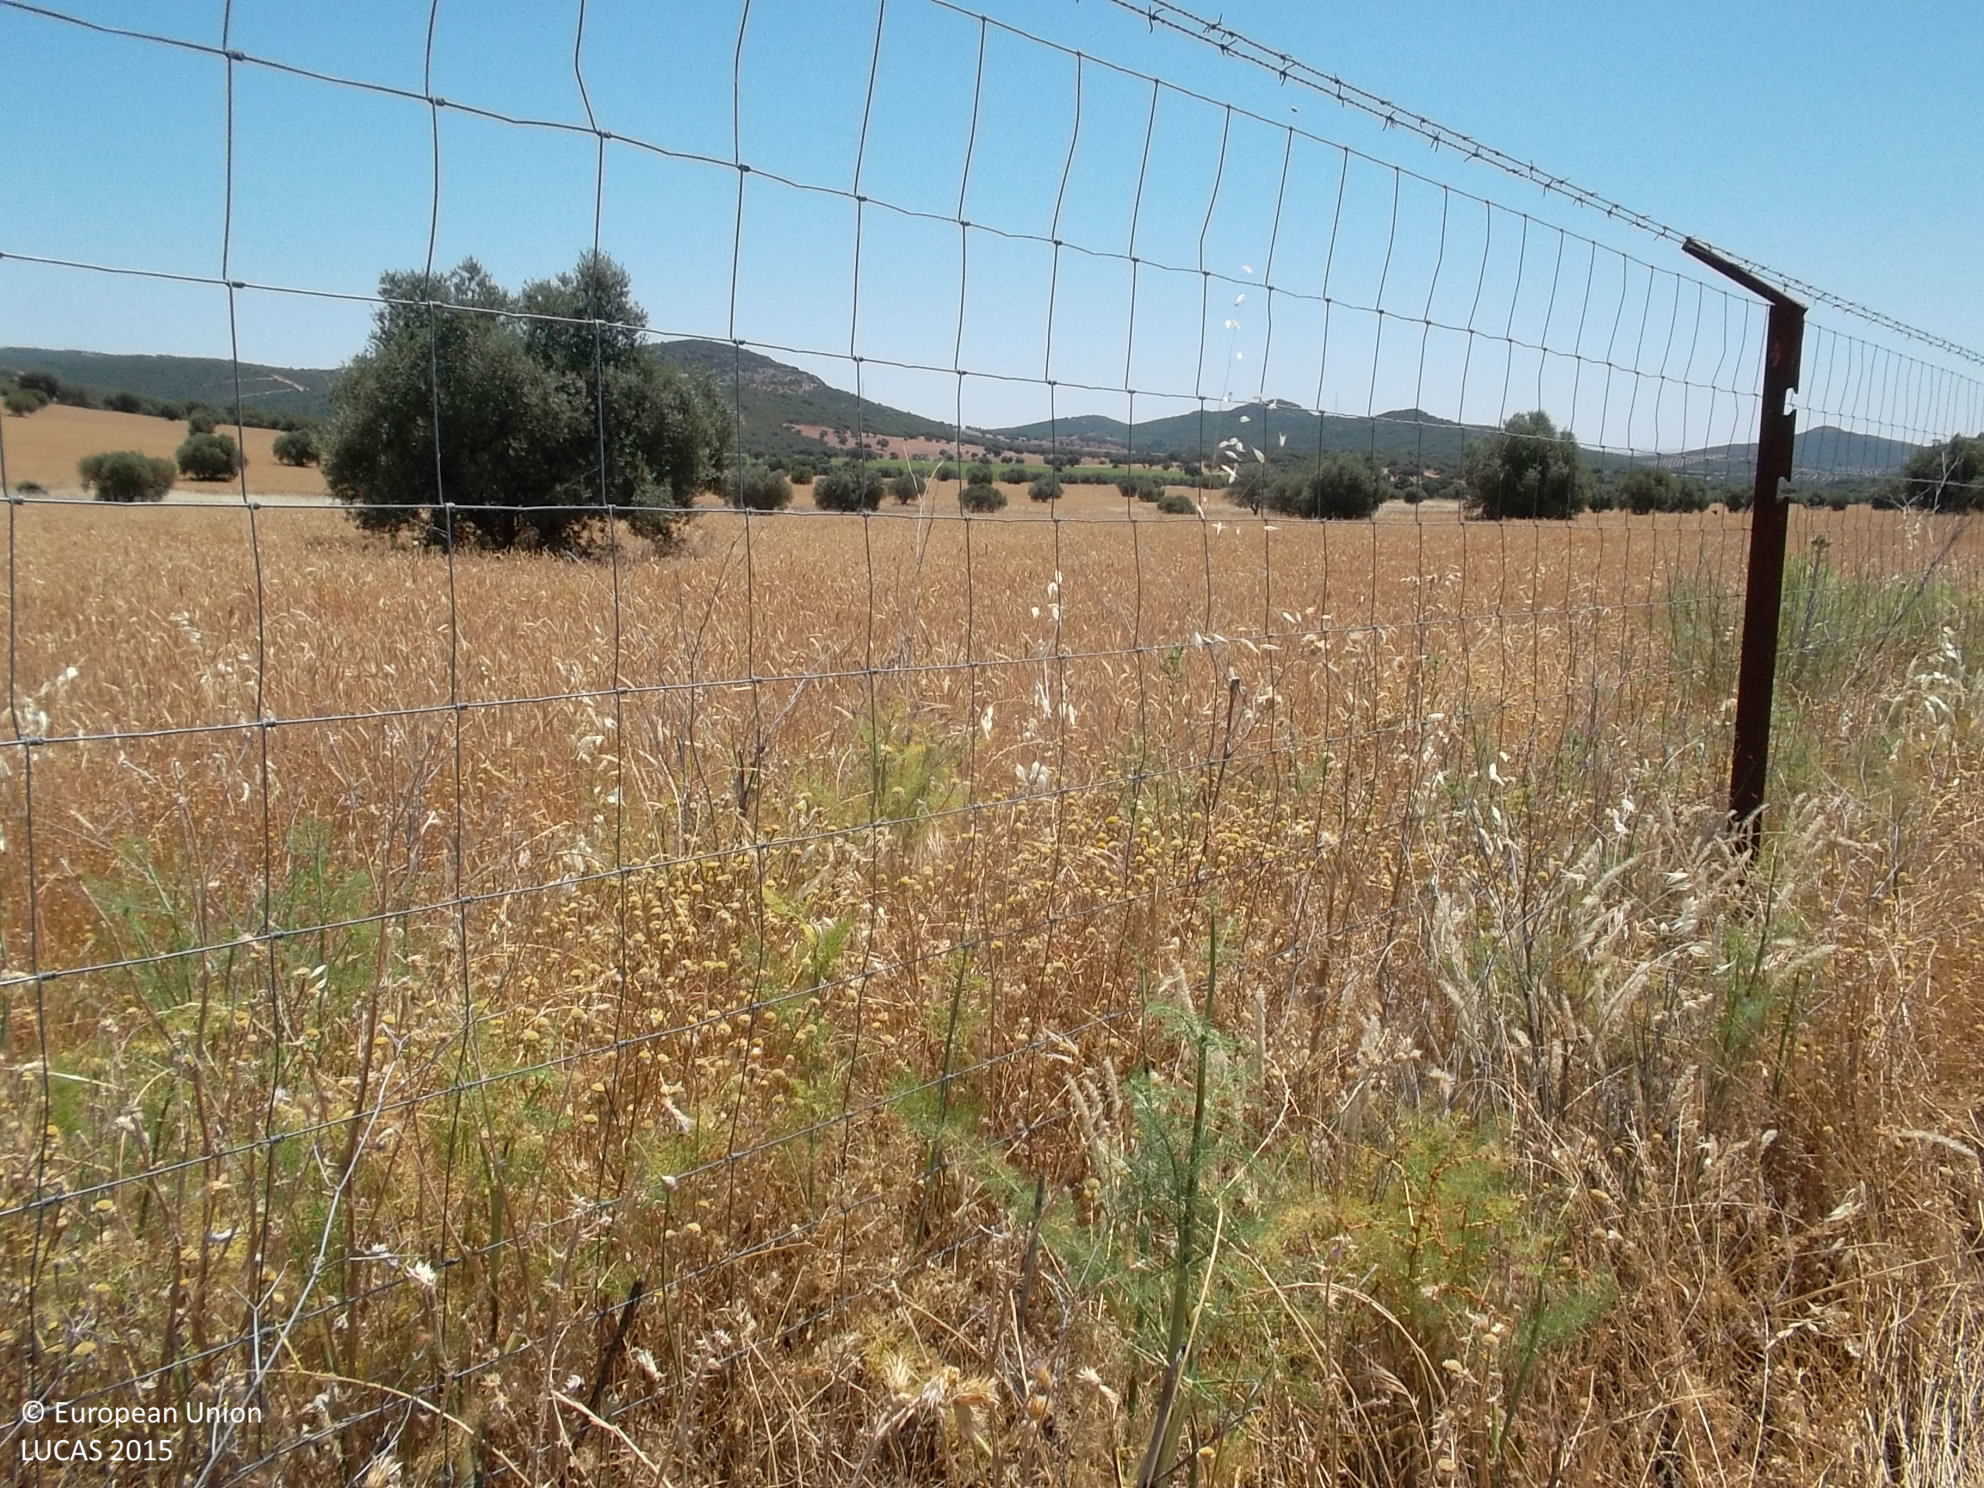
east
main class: Cropland
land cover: Common wheat
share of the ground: > 75 %
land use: Agriculture (excluding fallow land and kitchen gardens)
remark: Harvested field
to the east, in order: Common wheat; Rivers and streams; Common wheat; Broadleaved woodland; Common wheat
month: June
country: ES
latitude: 39.0973
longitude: -4.0959
